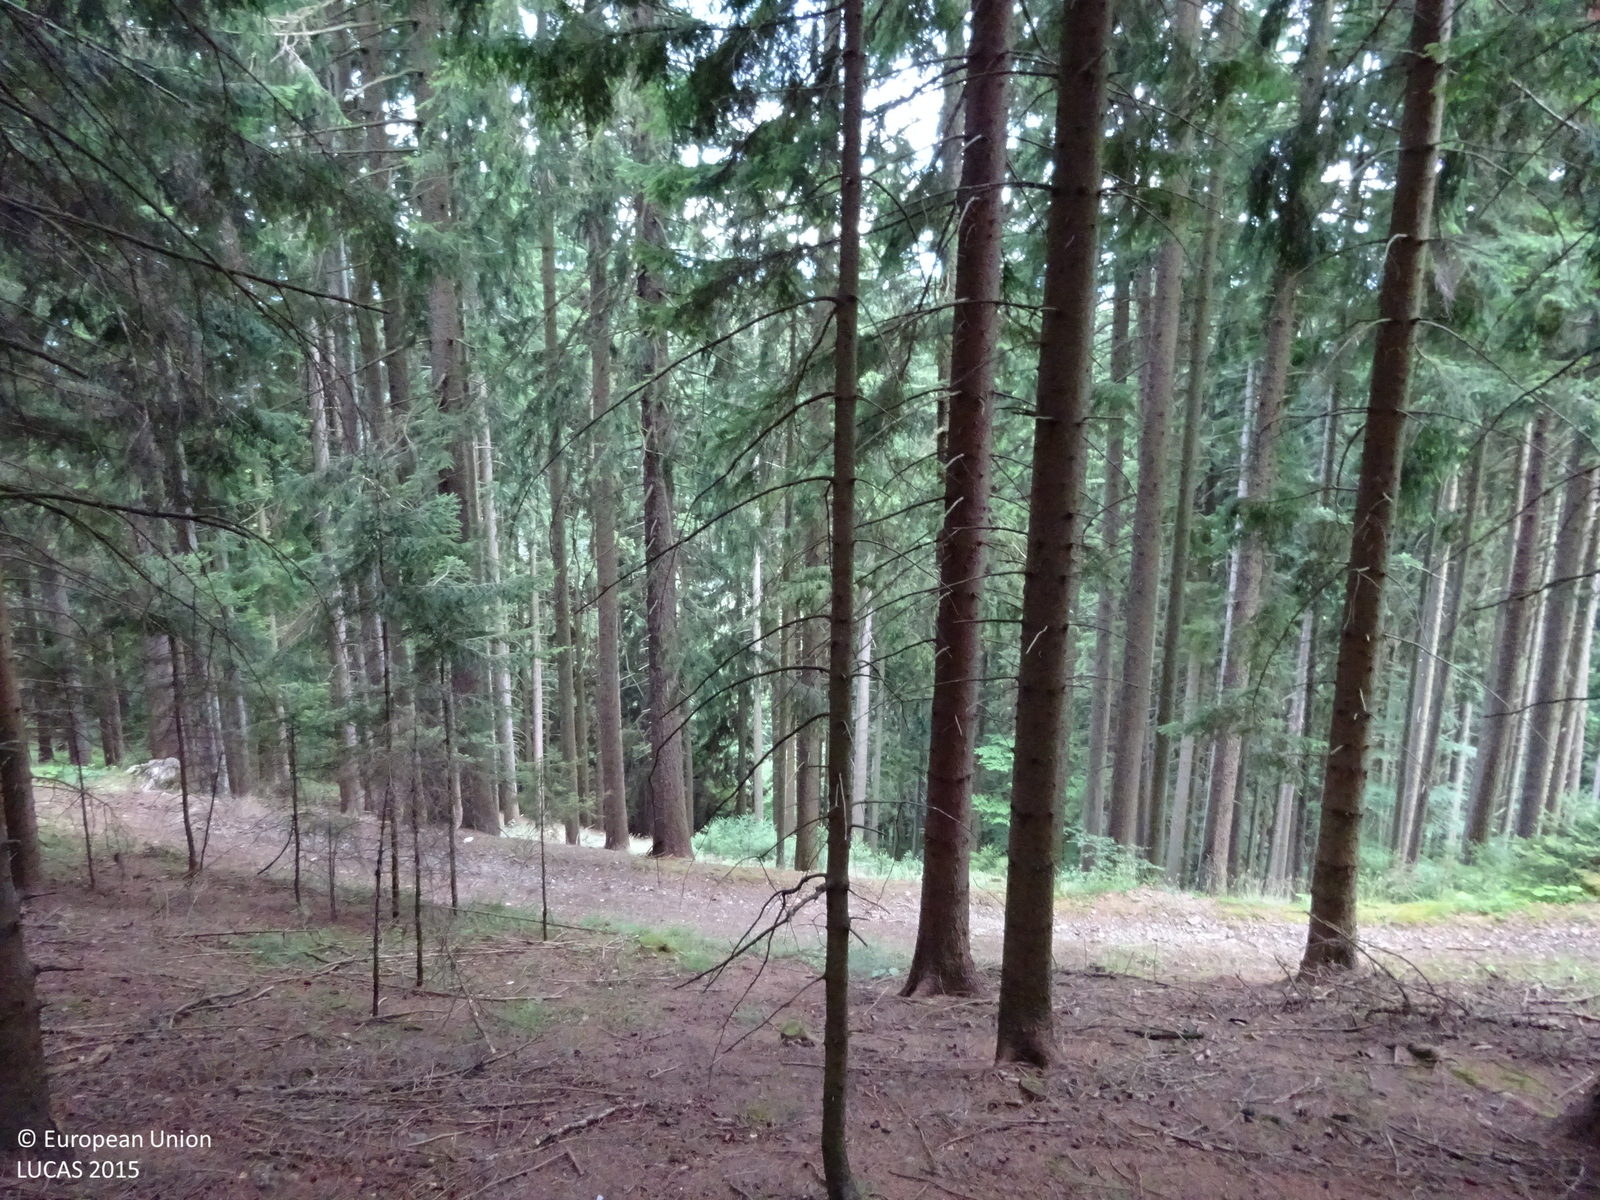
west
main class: Woodland
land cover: Spruce dominated coniferous woodland
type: alpine coniferous forest
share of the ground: > 75 %
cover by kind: coniferous forest trees 100 %
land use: Forestry
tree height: > 5 m
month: July
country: AT
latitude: 47.1881
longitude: 15.4242
